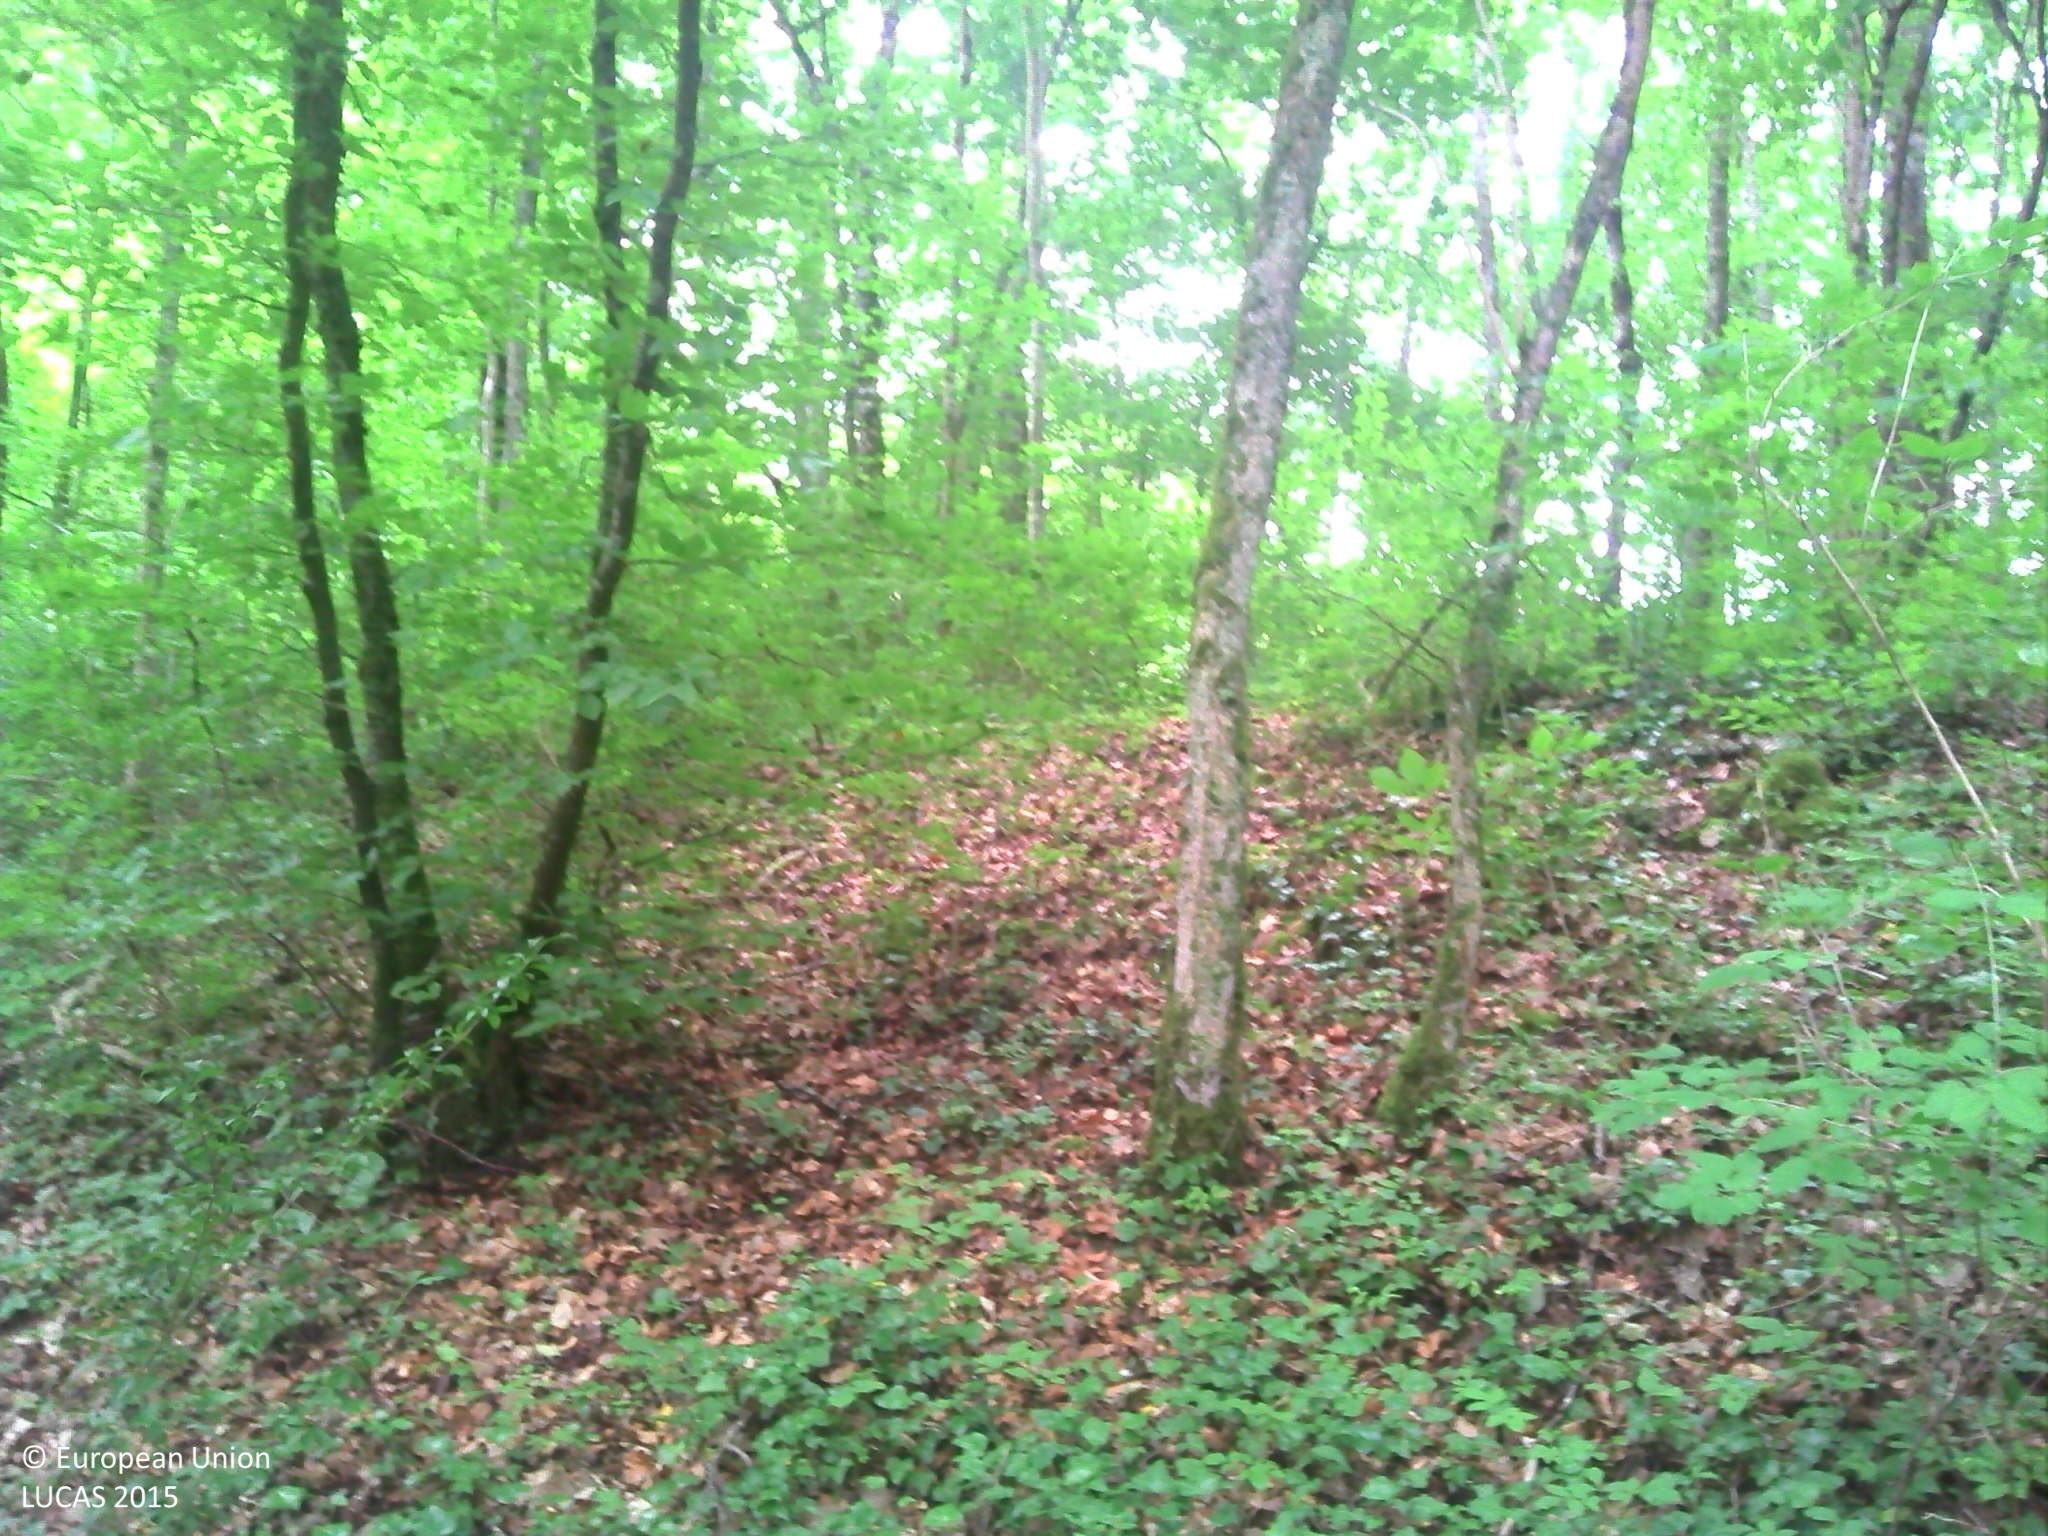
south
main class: Woodland
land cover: Broadleaved woodland
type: acidophilous oak and oak-birch forest
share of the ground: > 75 %
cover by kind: broadleaved forest trees 90 %, herbaceous plants 10 %
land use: Forestry
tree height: > 5 m
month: June
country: FR
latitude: 48.2341
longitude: 4.9499
